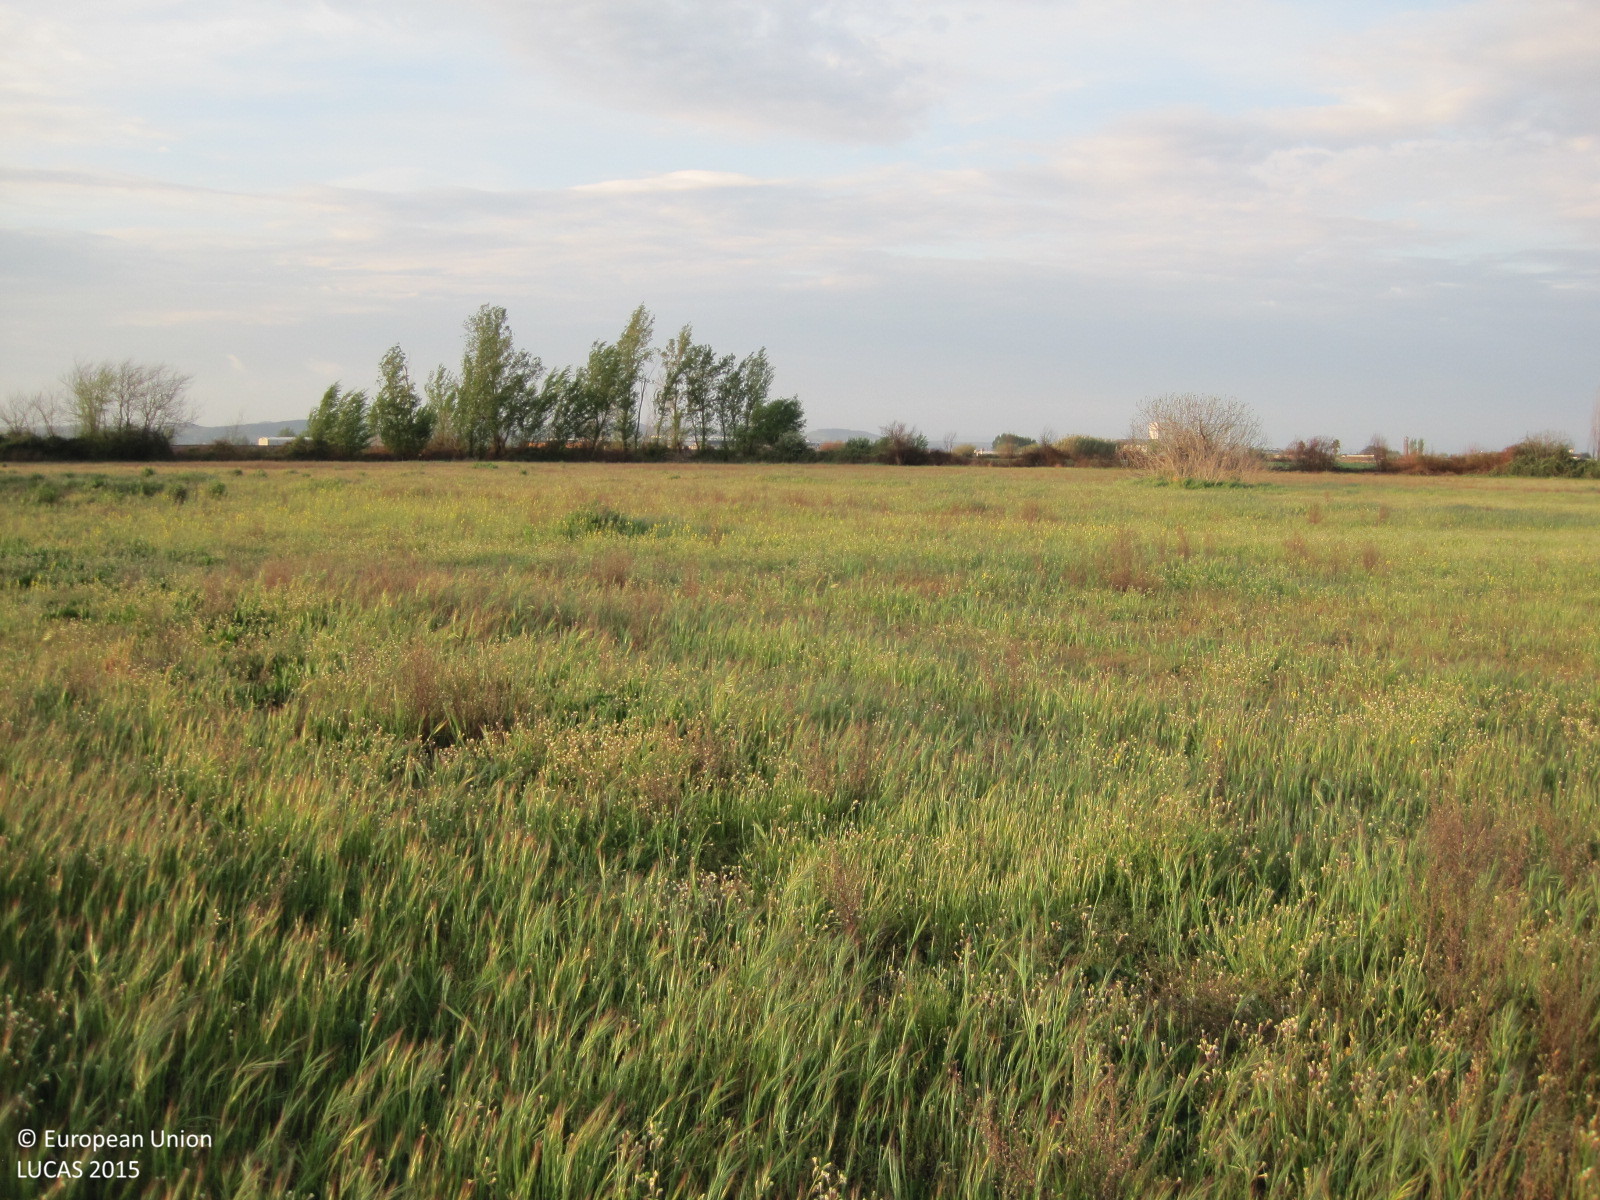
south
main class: Grassland
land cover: Spontaneously vegetated surfaces
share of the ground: > 75 %
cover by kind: herbaceous plants 100 %
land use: Fallow land
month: April
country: ES
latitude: 39.9272
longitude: -4.9205
